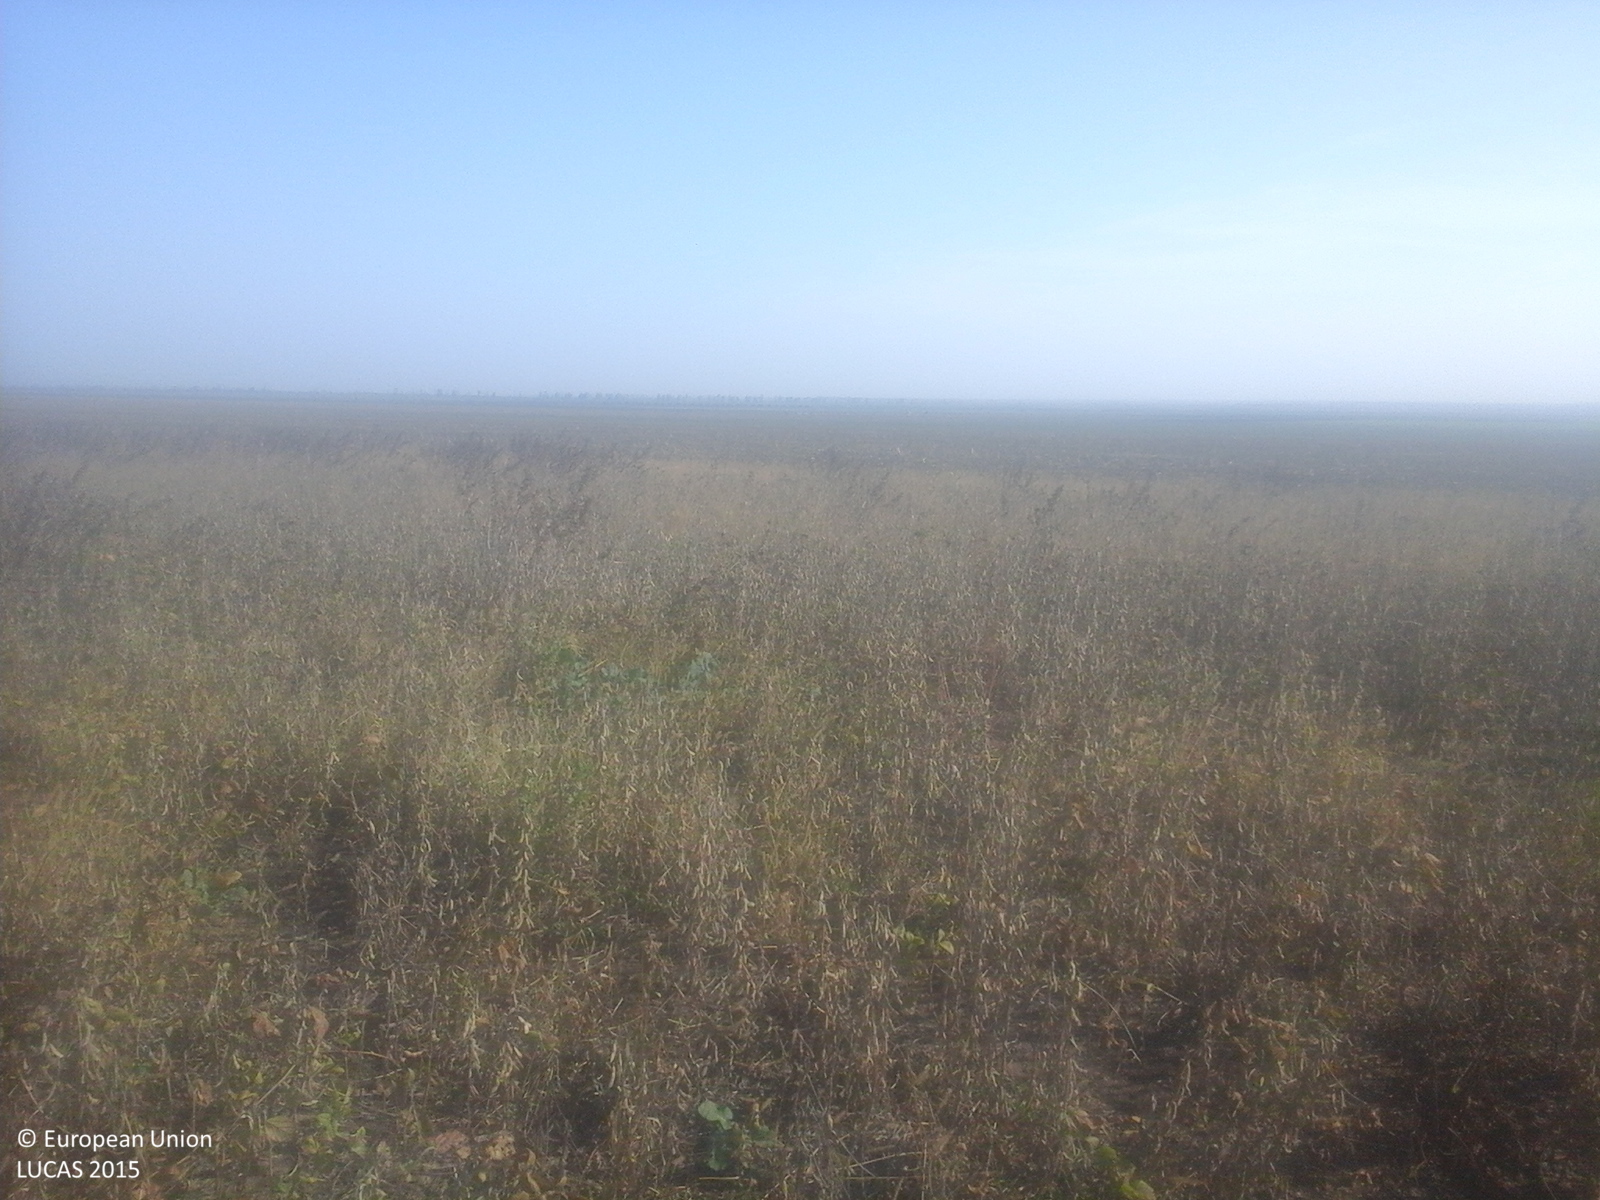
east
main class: Cropland
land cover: Soya
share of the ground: > 75 %
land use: Agriculture (excluding fallow land and kitchen gardens)
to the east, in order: Soya; Maize
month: October
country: RO
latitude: 45.3283
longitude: 26.9917
